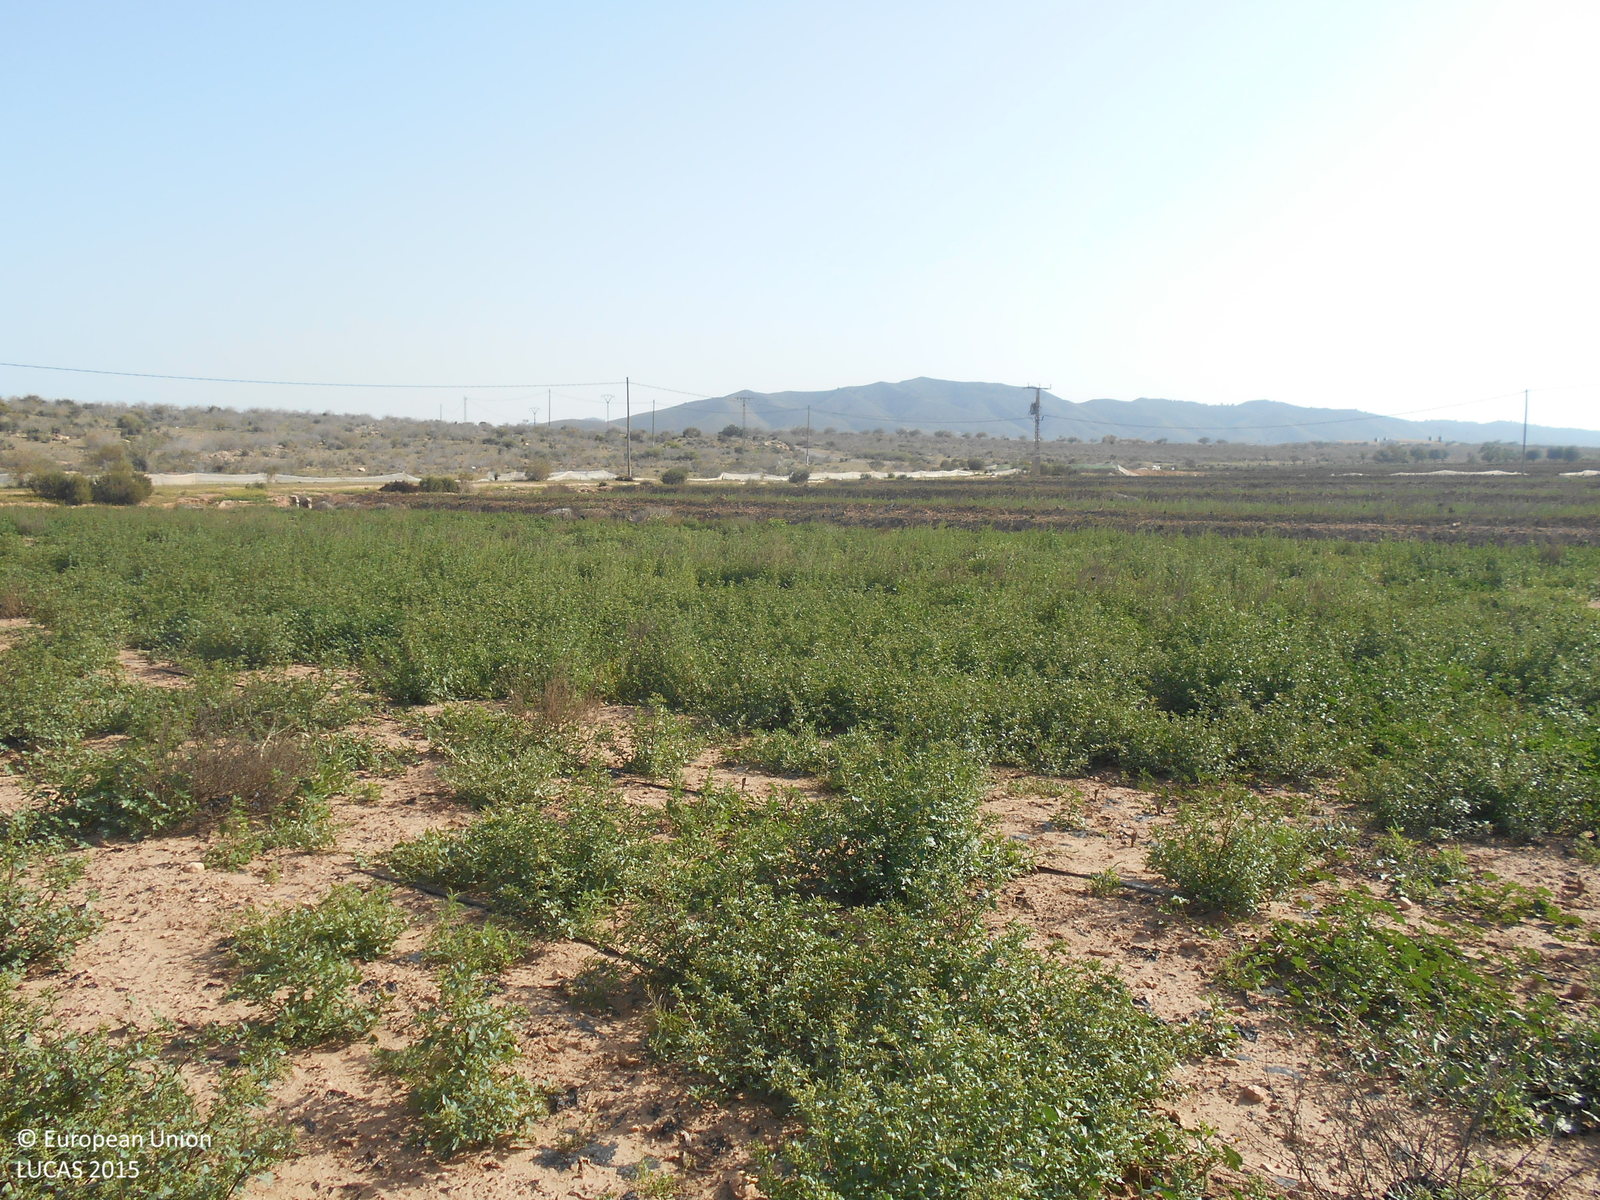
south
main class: Grassland
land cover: Spontaneously vegetated surfaces
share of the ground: 50 - 75 %
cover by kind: herbaceous plants 70 %, unconsolidated bare surface 30 %
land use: Fallow land
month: April
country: ES
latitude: 37.7095
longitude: -1.4727
